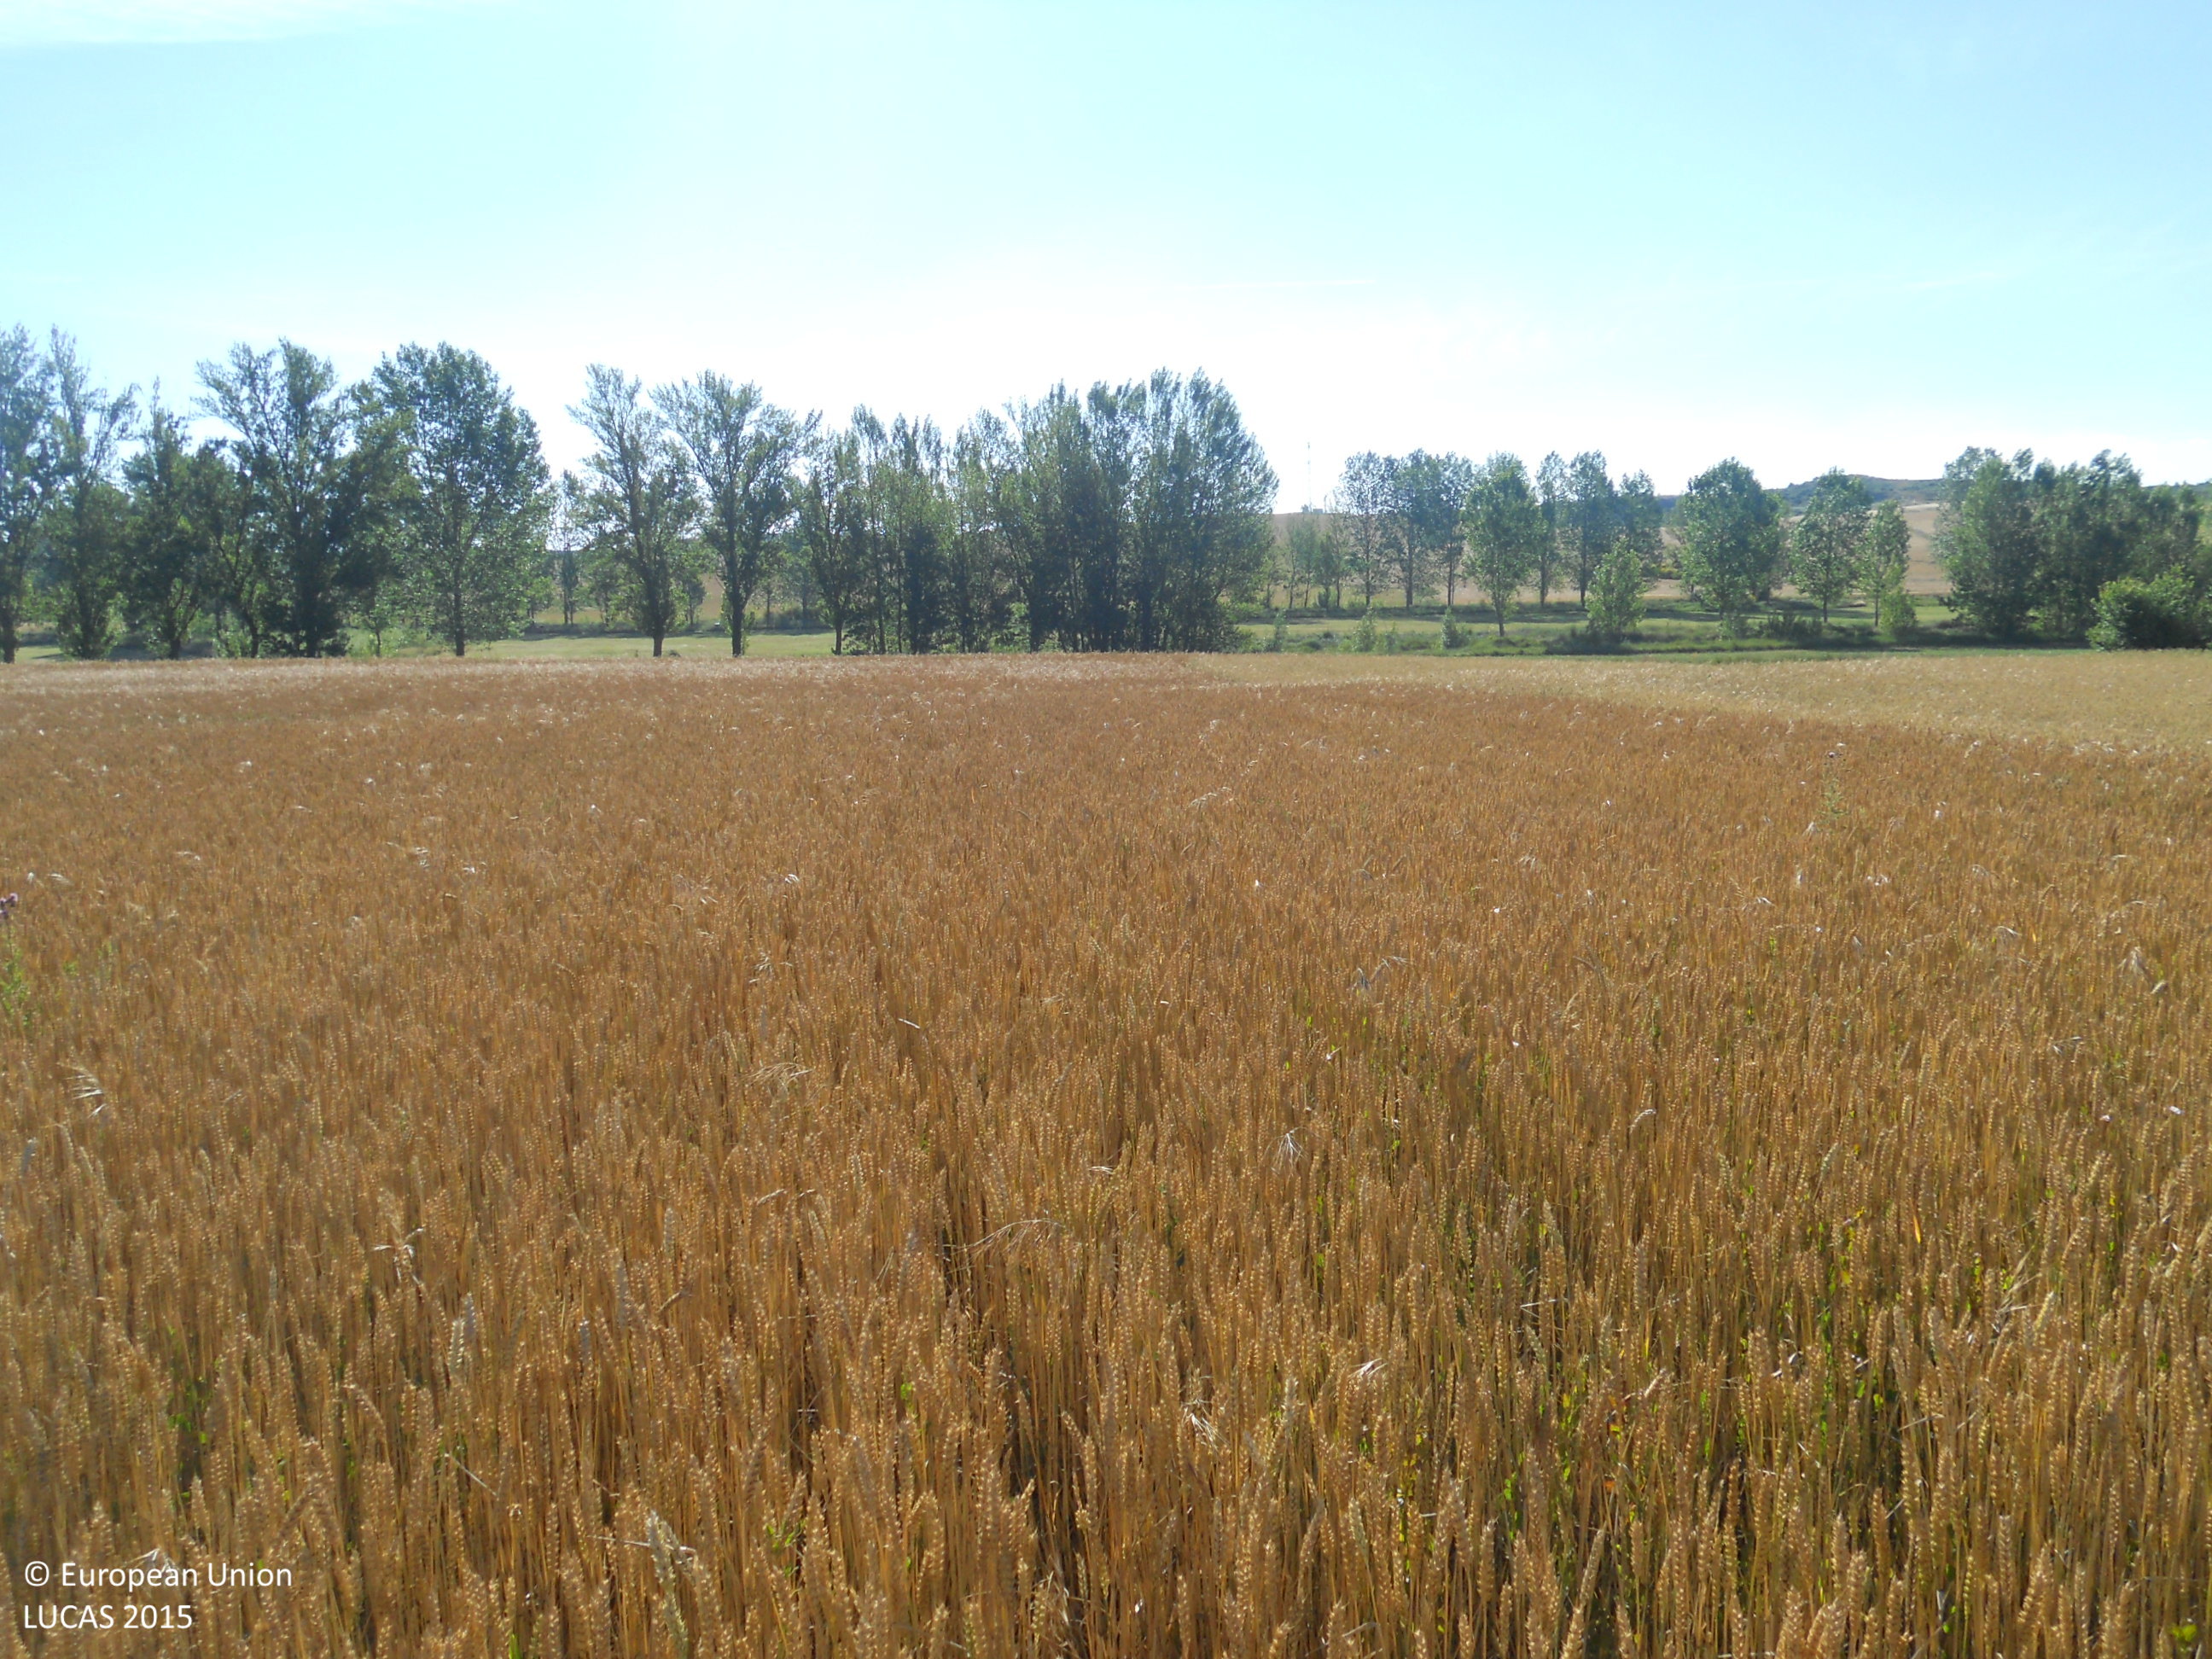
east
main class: Cropland
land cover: Common wheat
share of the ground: > 75 %
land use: Agriculture (excluding fallow land and kitchen gardens)
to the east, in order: Common wheat; Grass margins; Tracks; Grass margins; Dry pulses; Grass margins; Lines of trees; Rivers and streams; Lines of trees; Temporary grasslands; Grass margins; Lines of trees; Tracks; Lines of trees; Rivers and streams; Common wheat
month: June
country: ES
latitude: 42.3615
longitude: -4.9557
